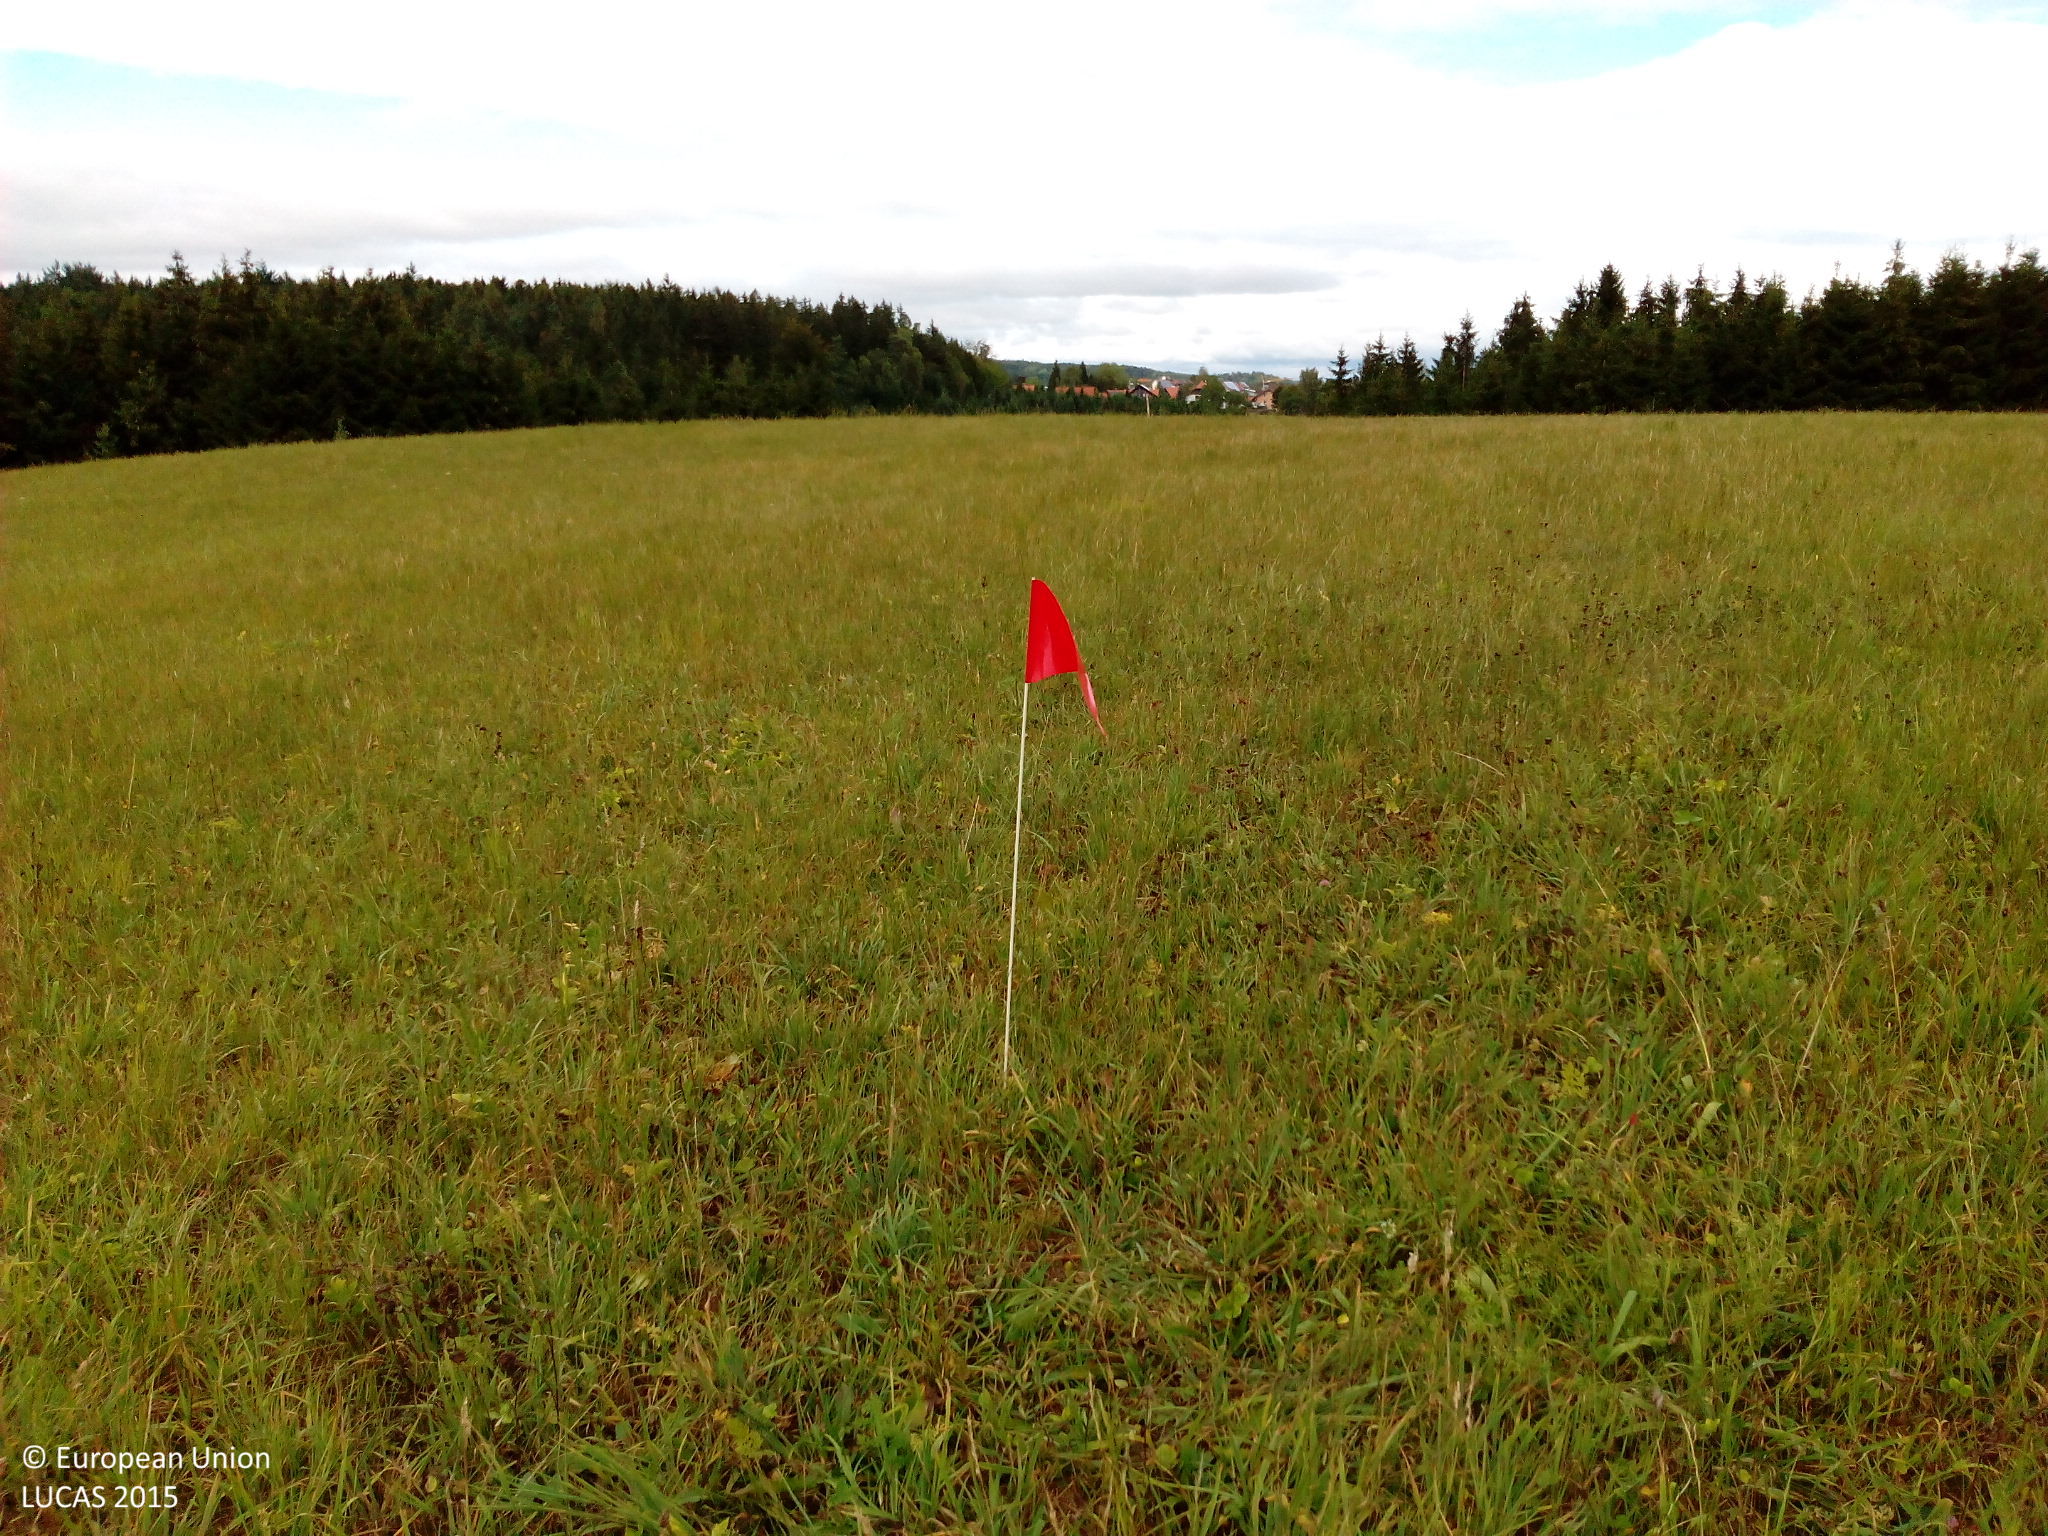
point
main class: Grassland
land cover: Grassland without tree/shrub cover
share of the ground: > 75 %
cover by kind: herbaceous plants 100 %
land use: Agriculture (excluding fallow land and kitchen gardens)
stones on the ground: < 10 %
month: August
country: DE
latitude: 47.6869
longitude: 8.2027
